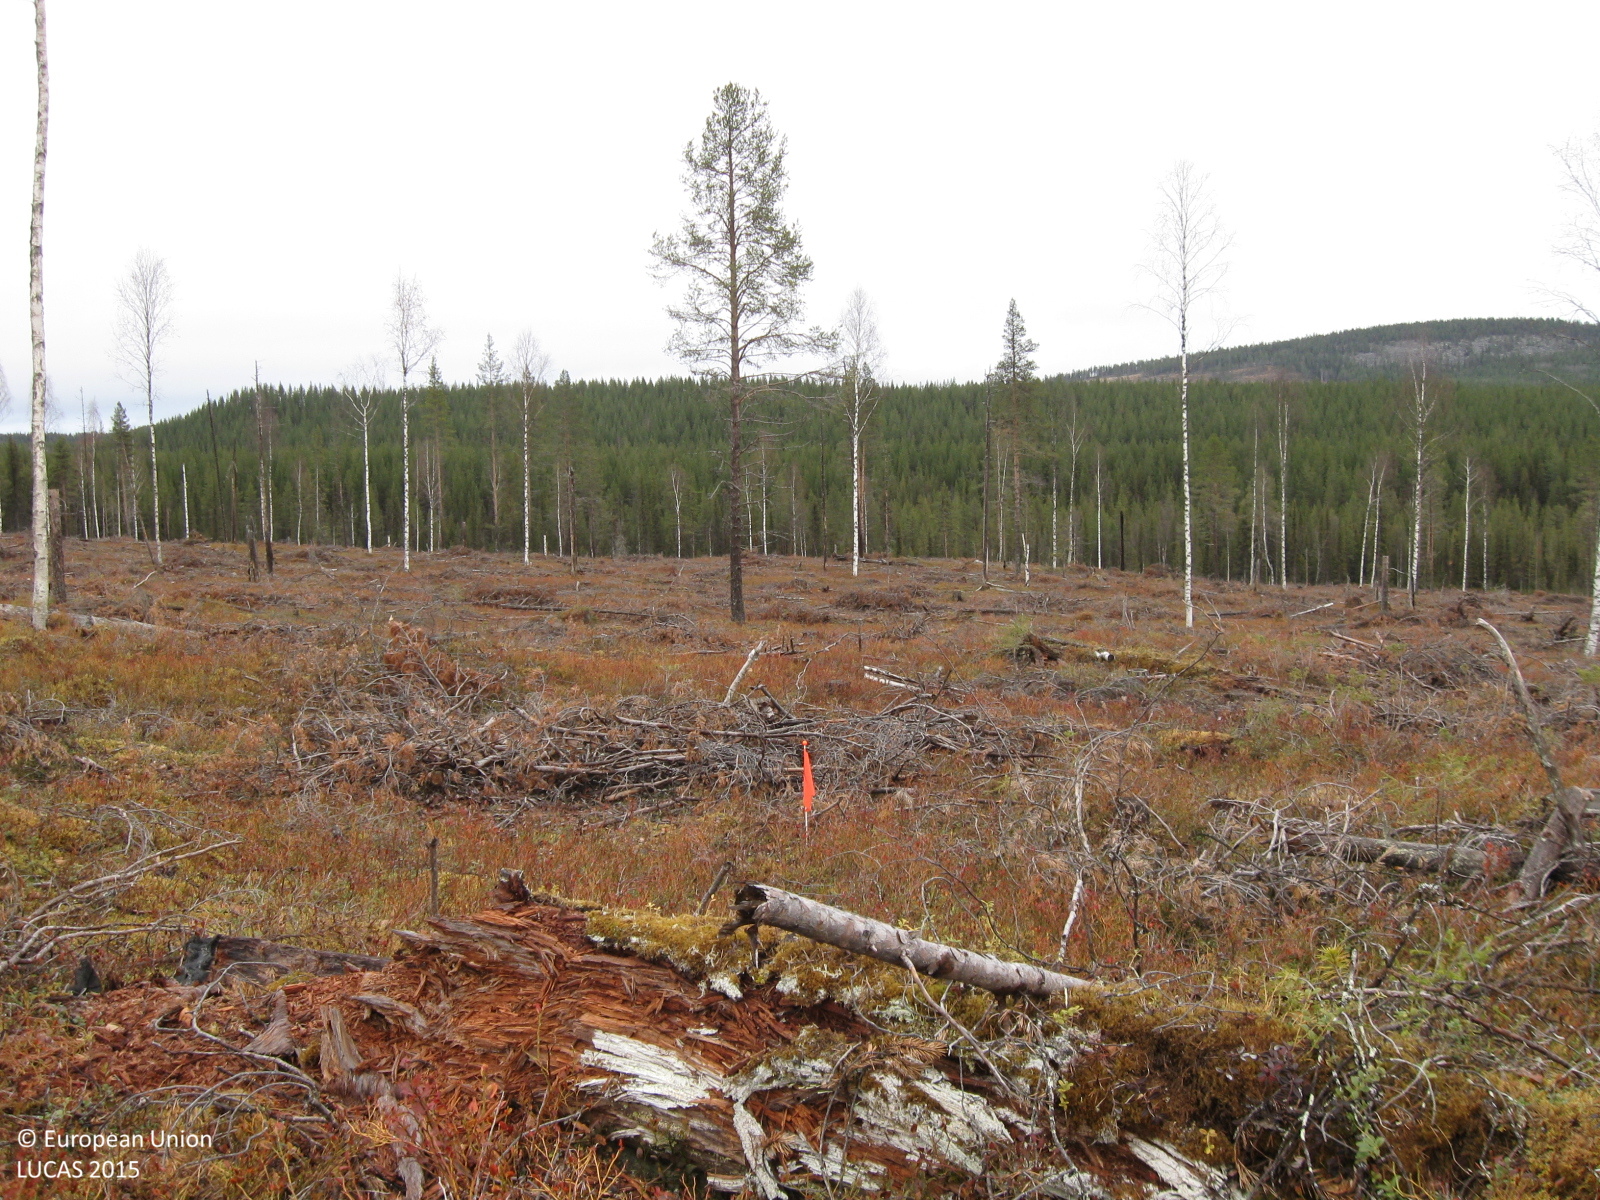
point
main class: Shrubland
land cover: Shrubland with sparse tree cover
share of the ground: 50 - 75 %
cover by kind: shrubs 65 %, lichens and mosses 15 %, herbaceous plants 10 %, coniferous forest trees 5 %
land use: Forestry
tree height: < 5 m
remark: Clear cut
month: October
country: SE
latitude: 66.7165
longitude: 21.6364
